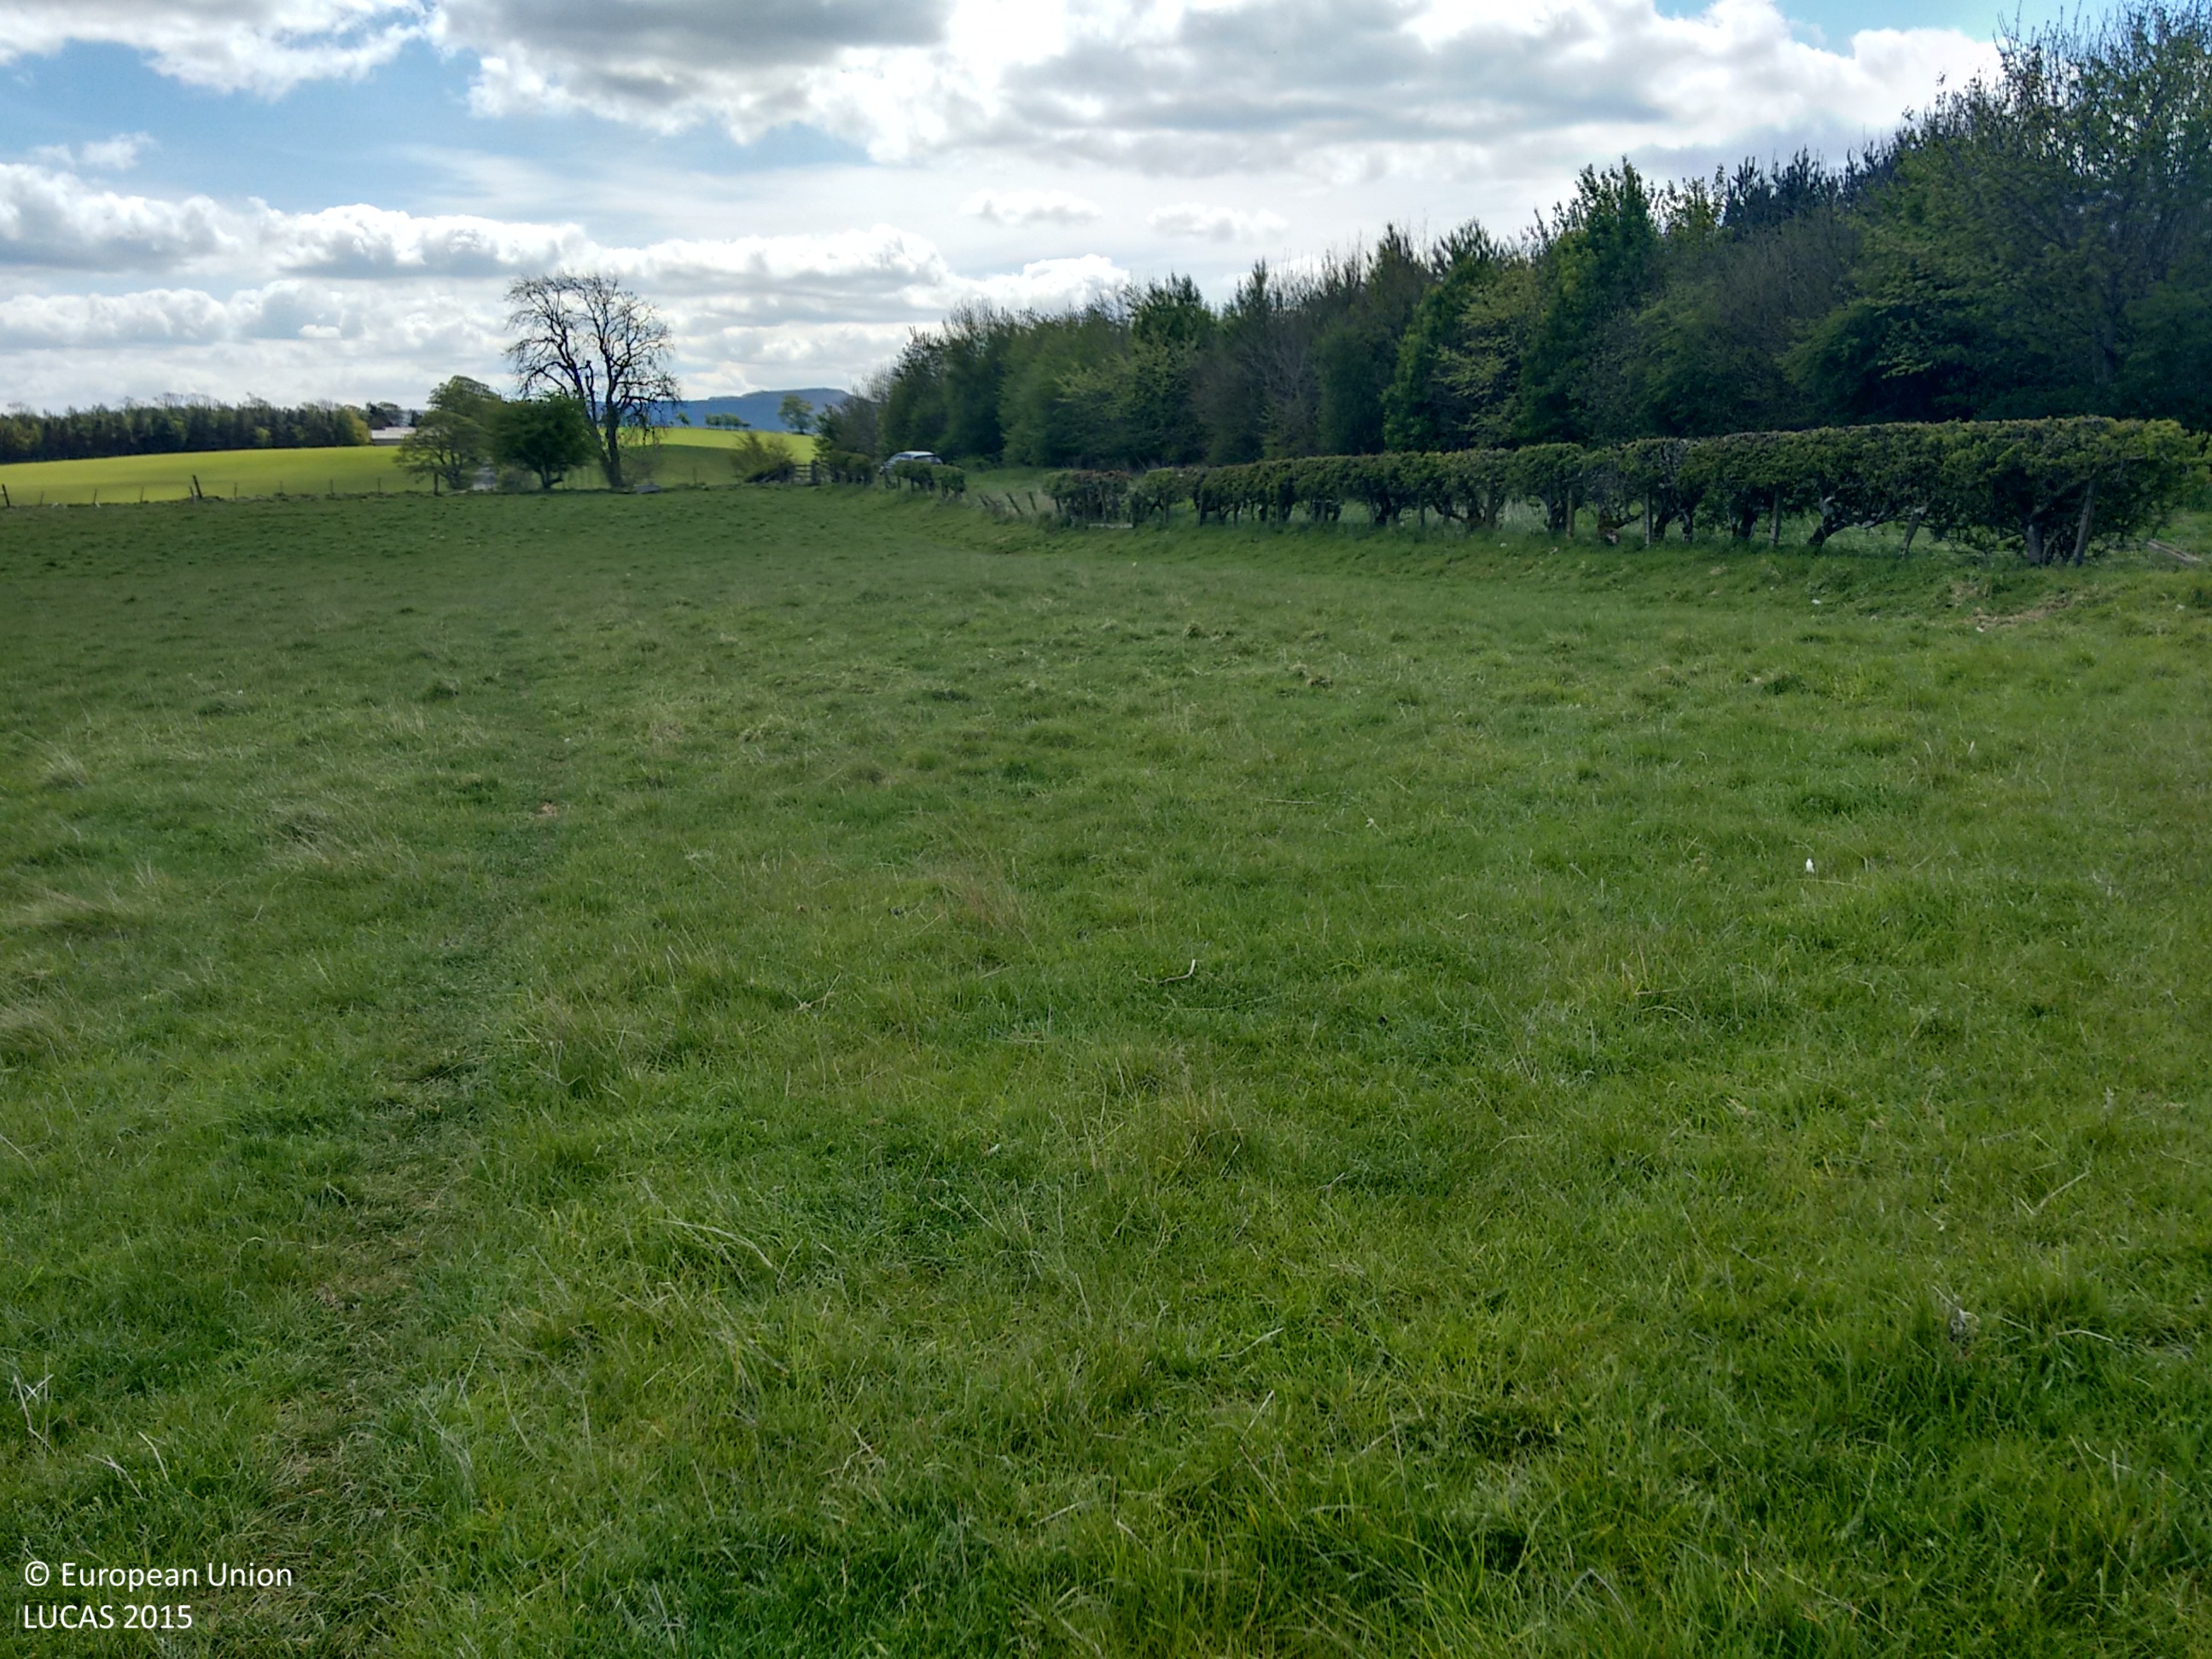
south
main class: Grassland
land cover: Grassland without tree/shrub cover
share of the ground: > 75 %
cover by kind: herbaceous plants 100 %
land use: Agriculture (excluding fallow land and kitchen gardens)
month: May
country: GB
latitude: 55.3500
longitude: -1.9919
